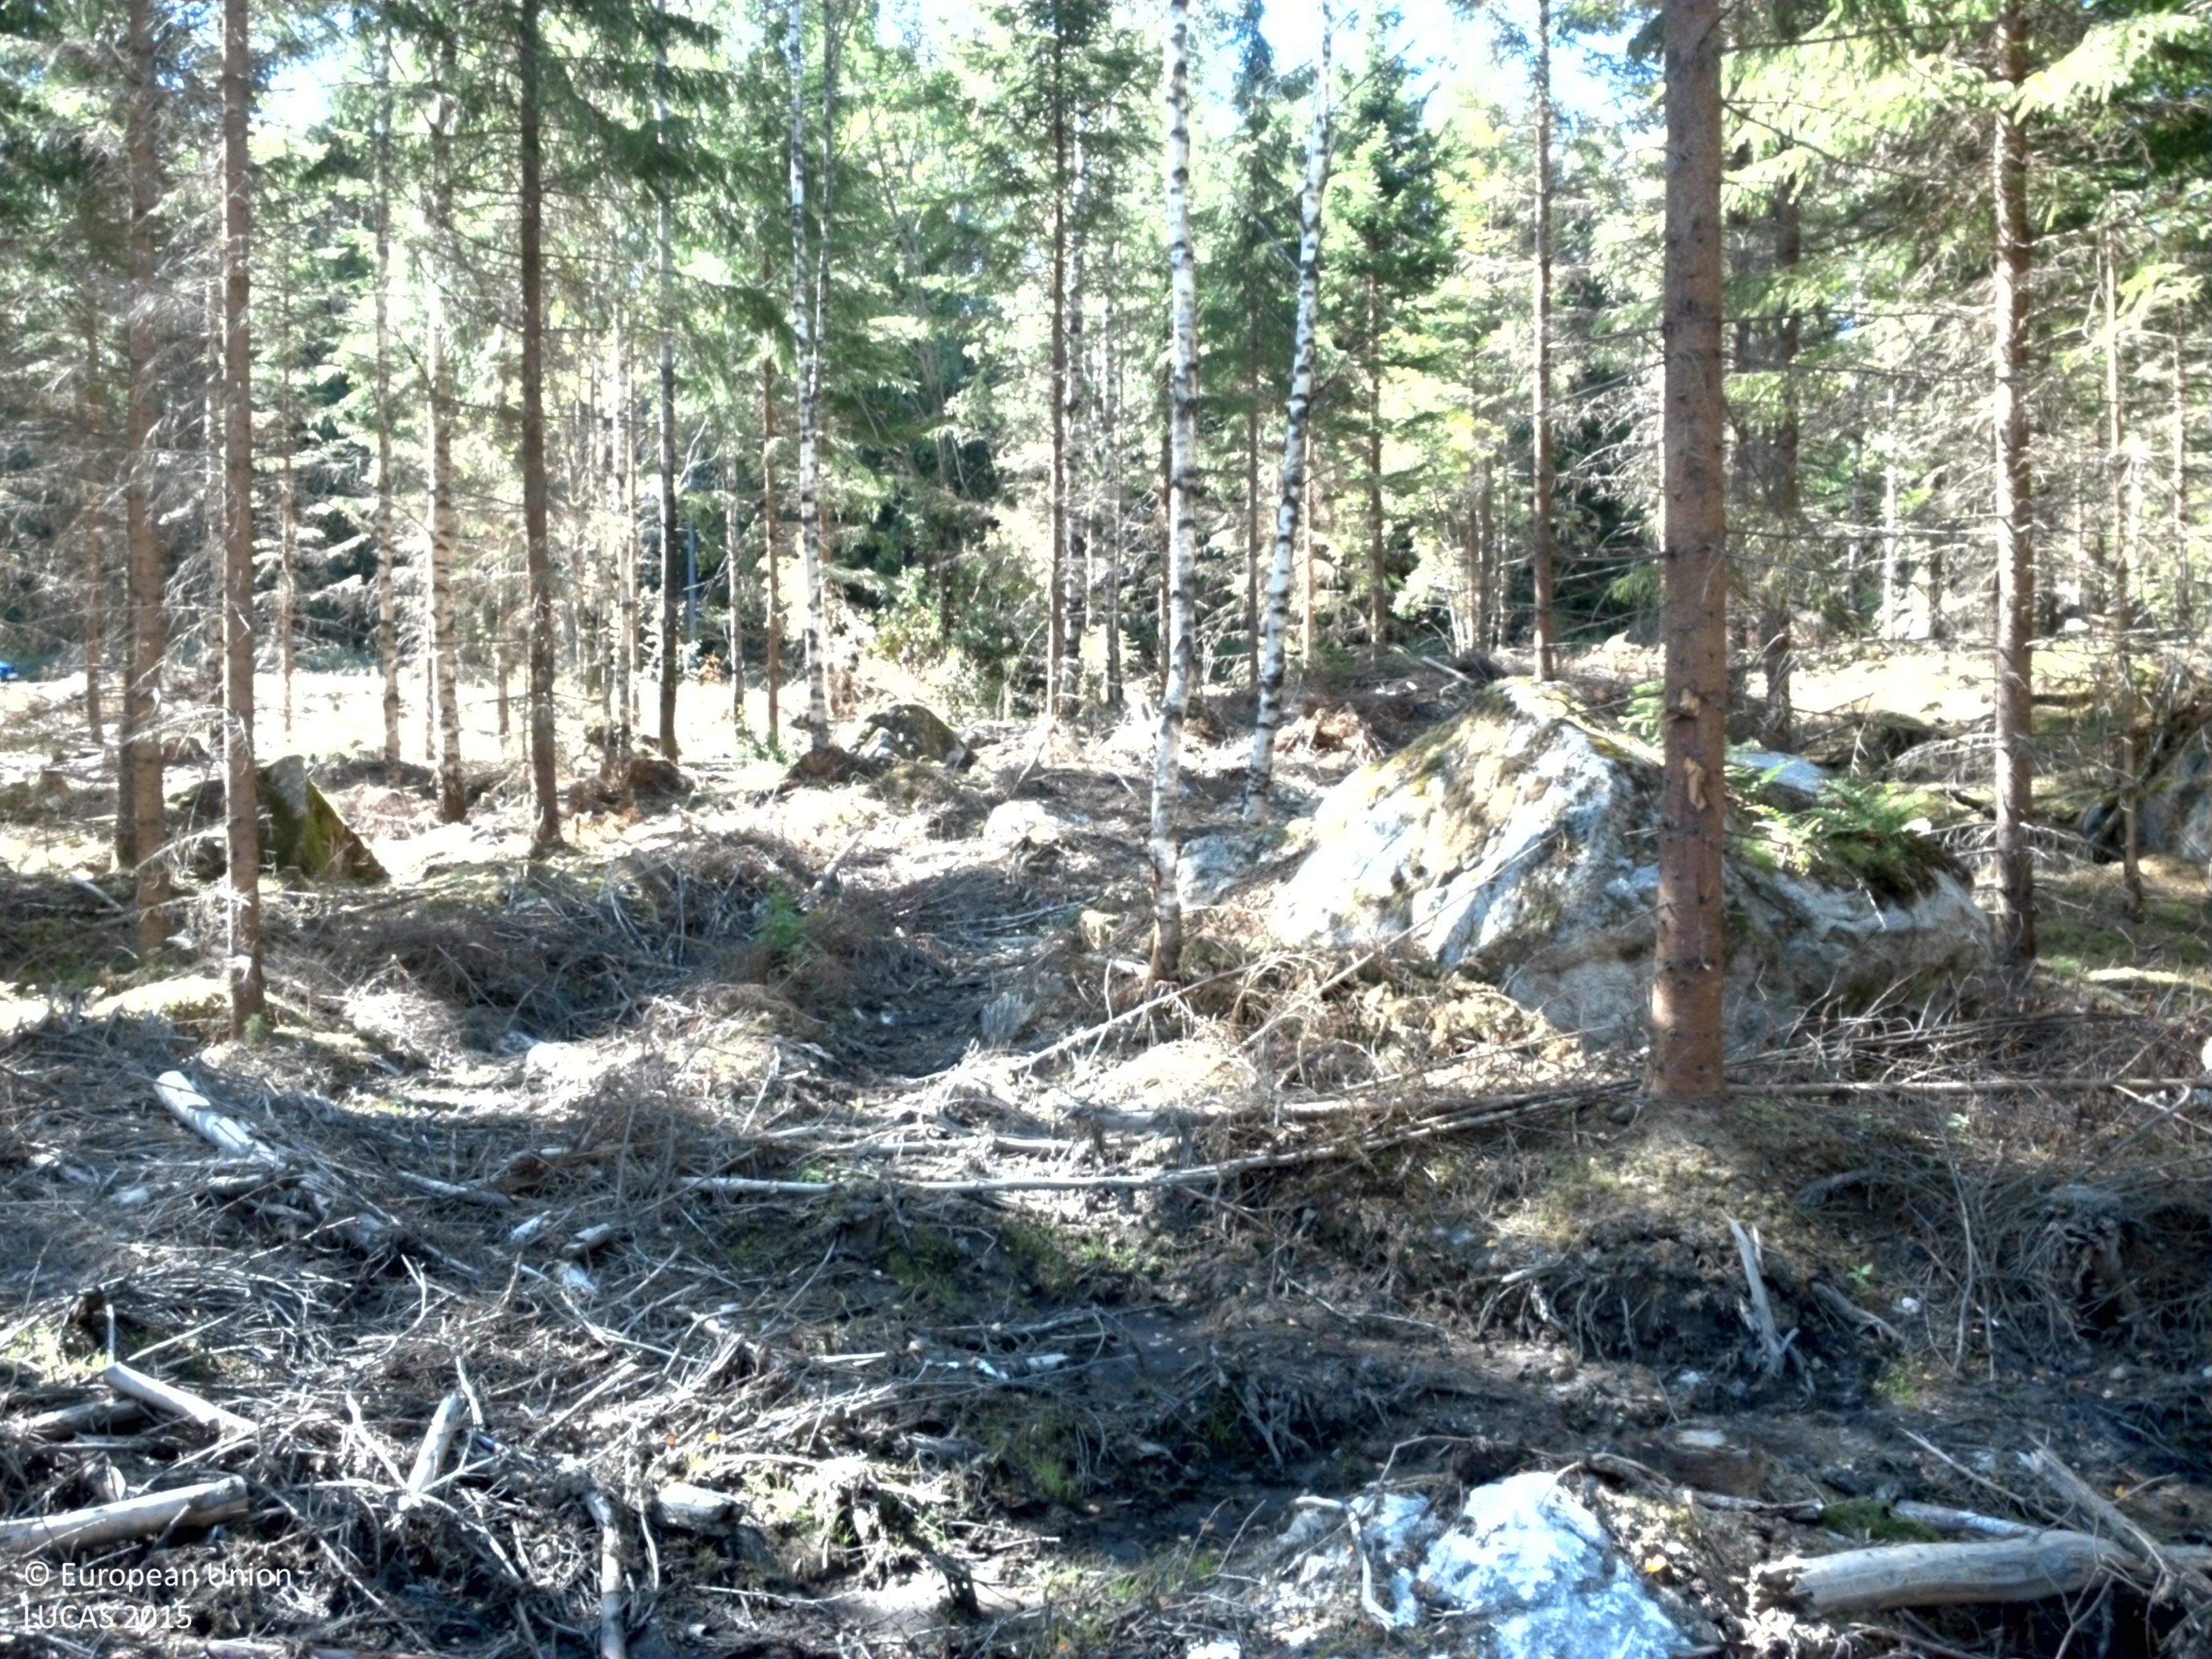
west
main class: Woodland
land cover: Spruce dominated mixed woodland
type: boreal forest
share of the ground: 50 - 75 %
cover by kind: coniferous forest trees 30 %, broadleaved forest trees 20 %, lichens and mosses 15 %, consolidated bare surface 10 %, shrubs 5 %
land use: Forestry
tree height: > 5 m
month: August
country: SE
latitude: 59.7415
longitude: 14.1360
